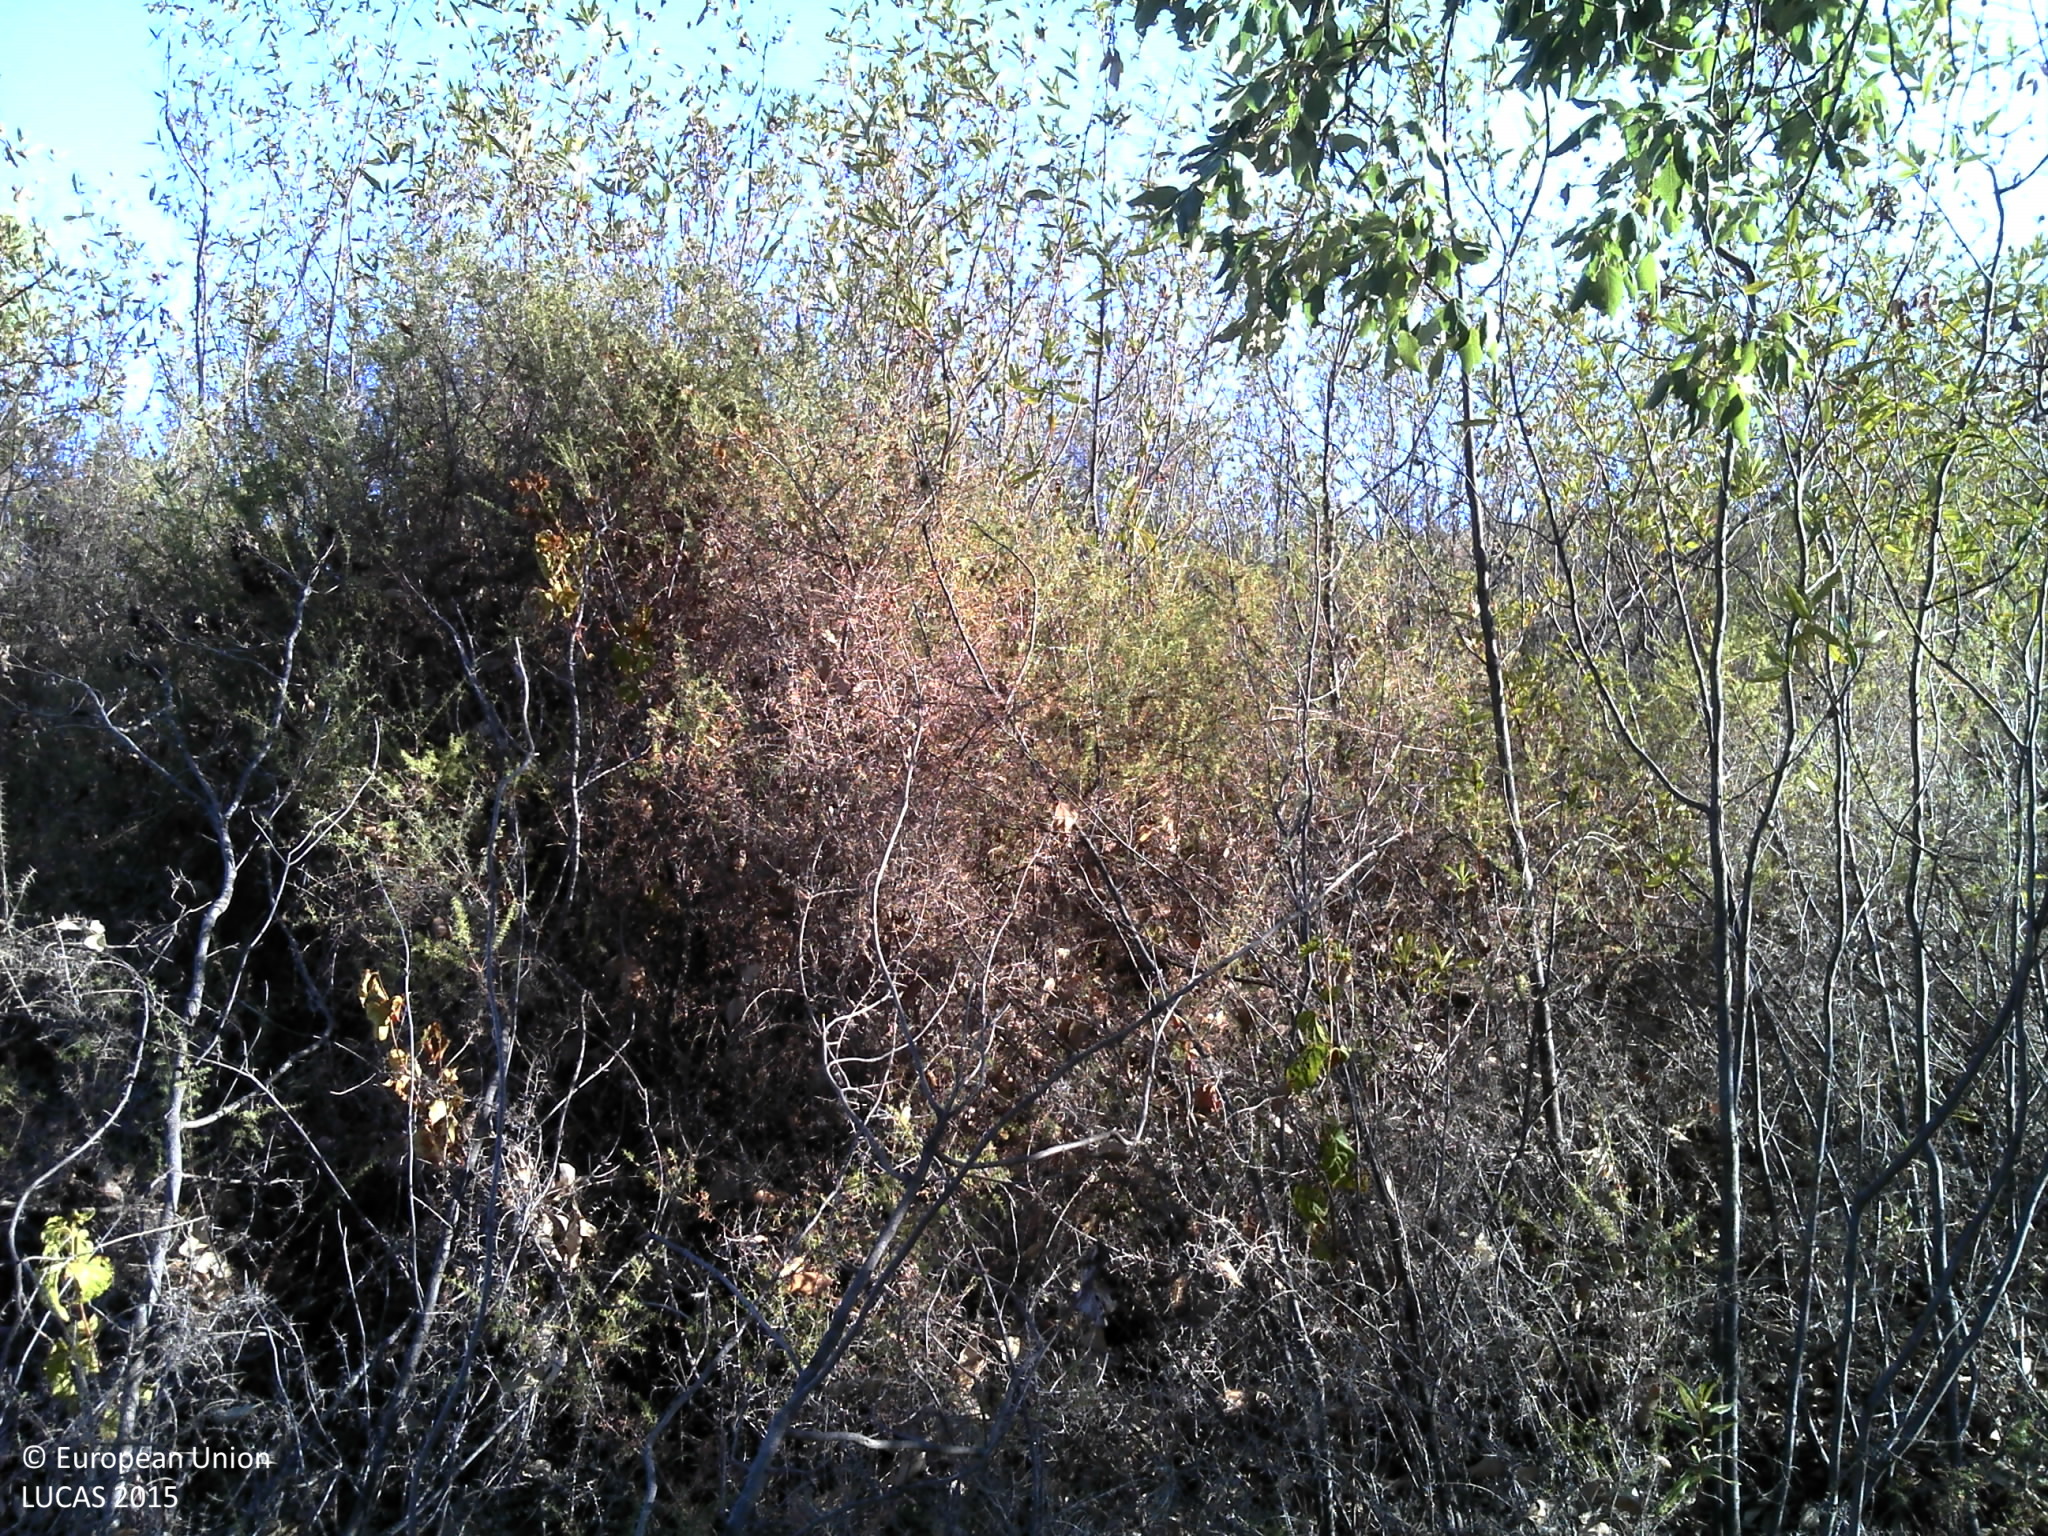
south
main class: Woodland
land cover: Broadleaved woodland
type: broadleaved evergreen forest
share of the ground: 25 - 50 %
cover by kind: broadleaved forest trees 40 %, shrubs 40 %, herbaceous plants 10 %, unconsolidated bare surface 10 %
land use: Forestry
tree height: > 5 m
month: September
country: PT
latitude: 37.4282
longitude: -8.2529
